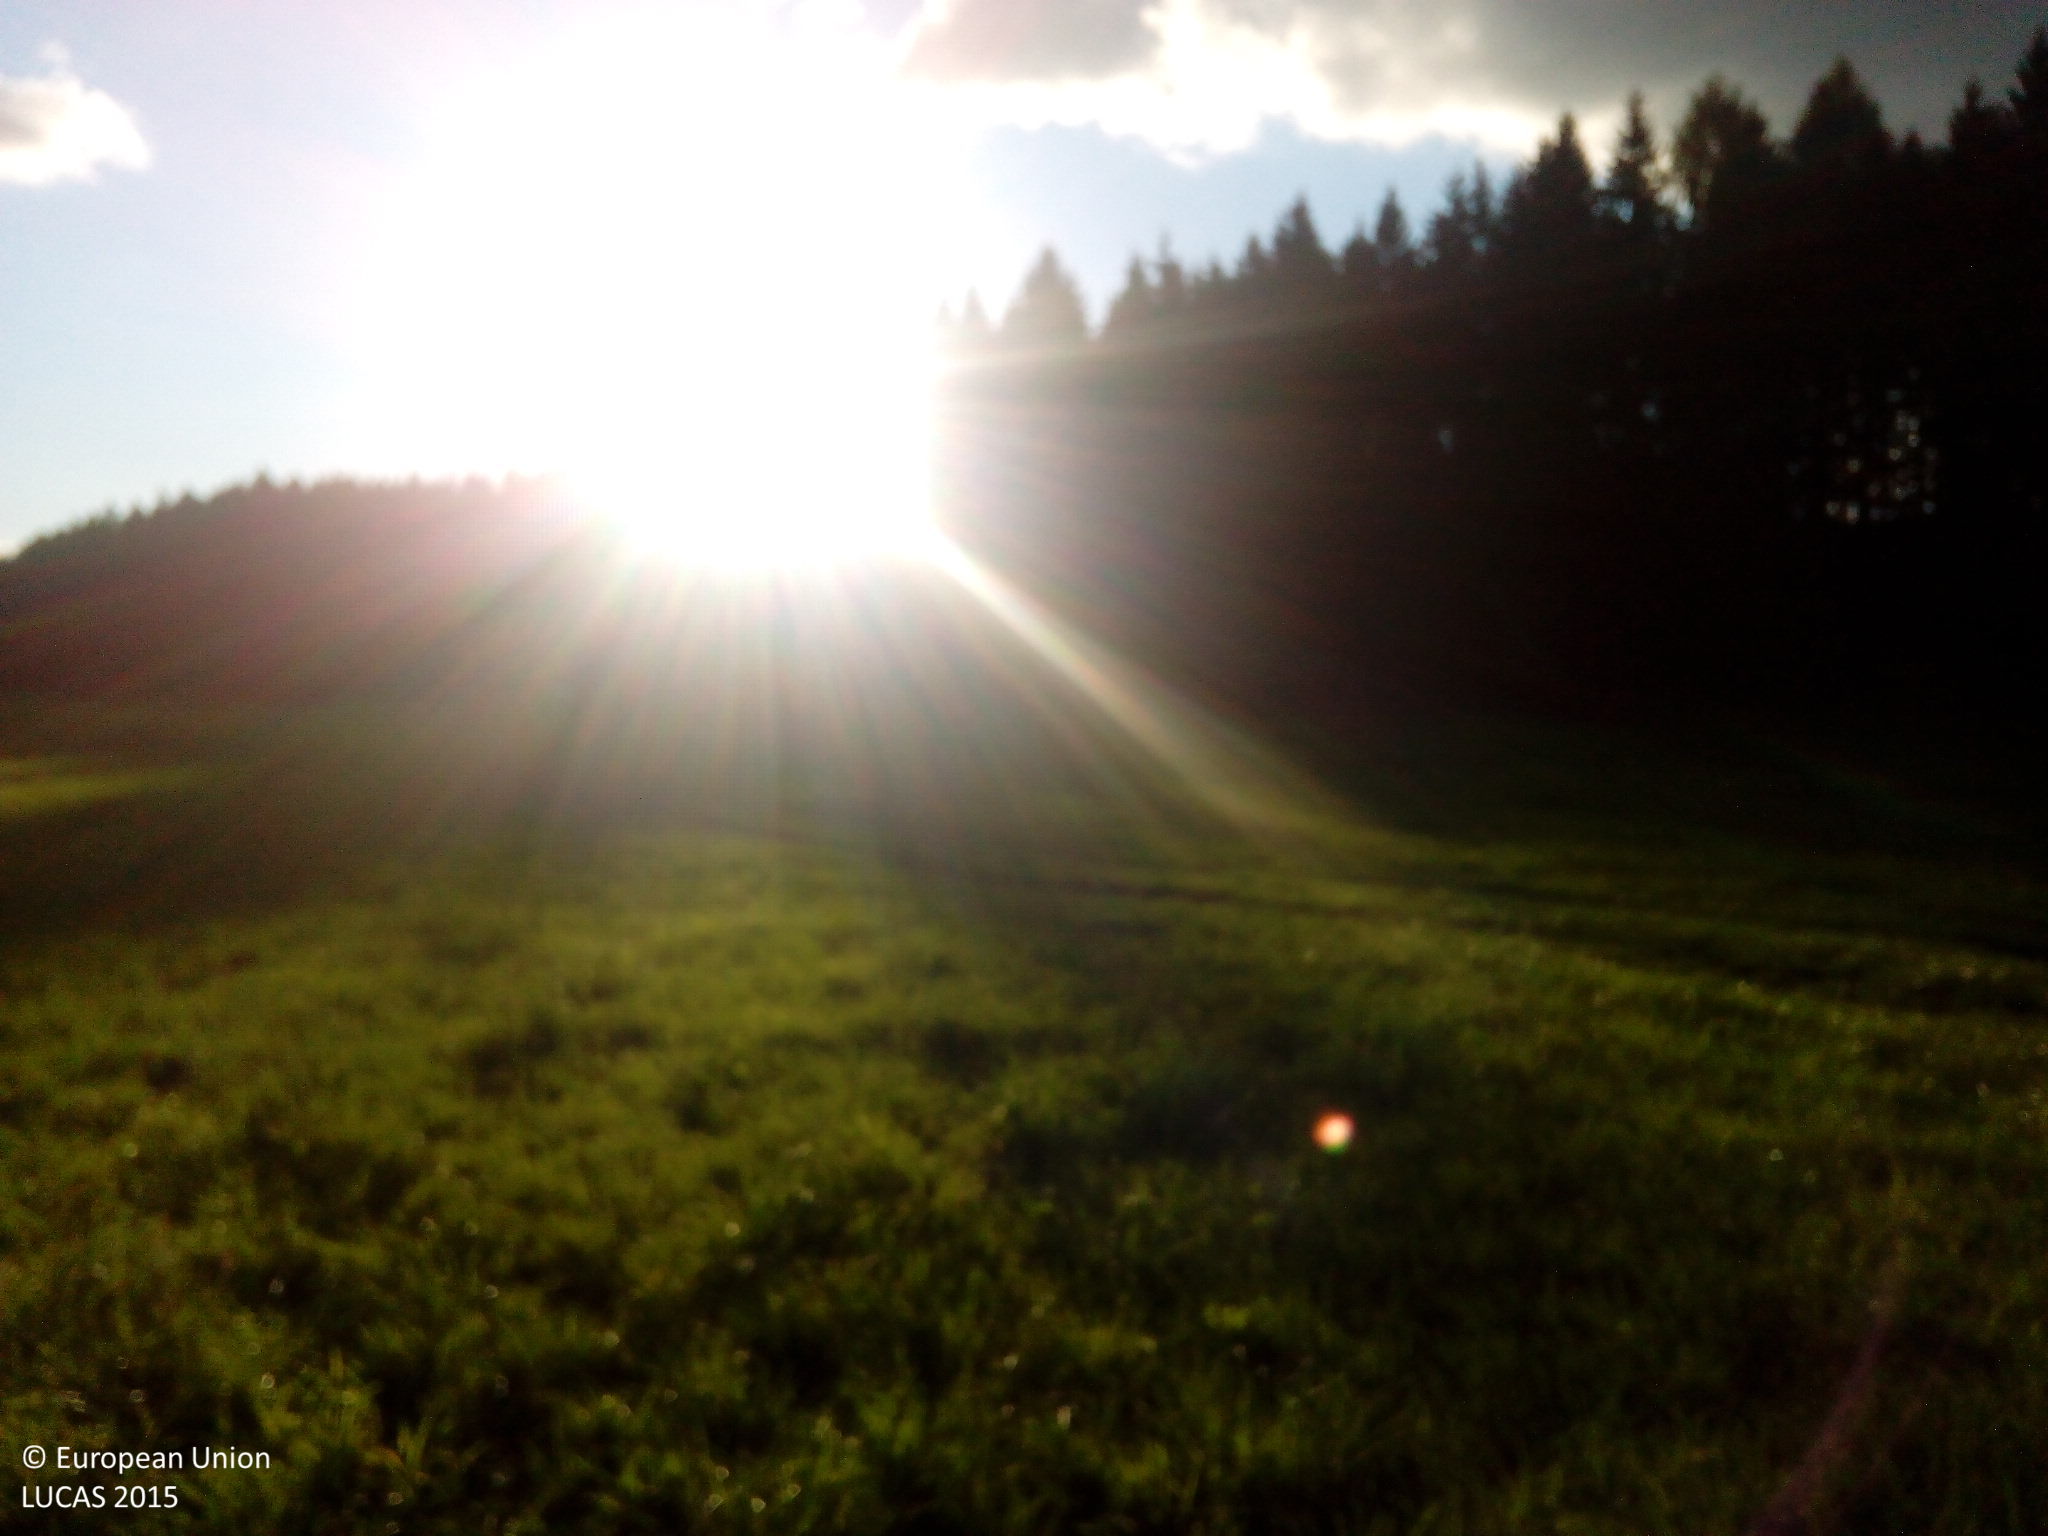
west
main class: Grassland
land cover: Grassland without tree/shrub cover
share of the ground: > 75 %
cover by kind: herbaceous plants 100 %
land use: Agriculture (excluding fallow land and kitchen gardens)
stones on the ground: < 10 %
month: September
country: DE
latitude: 51.5633
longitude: 11.1105
